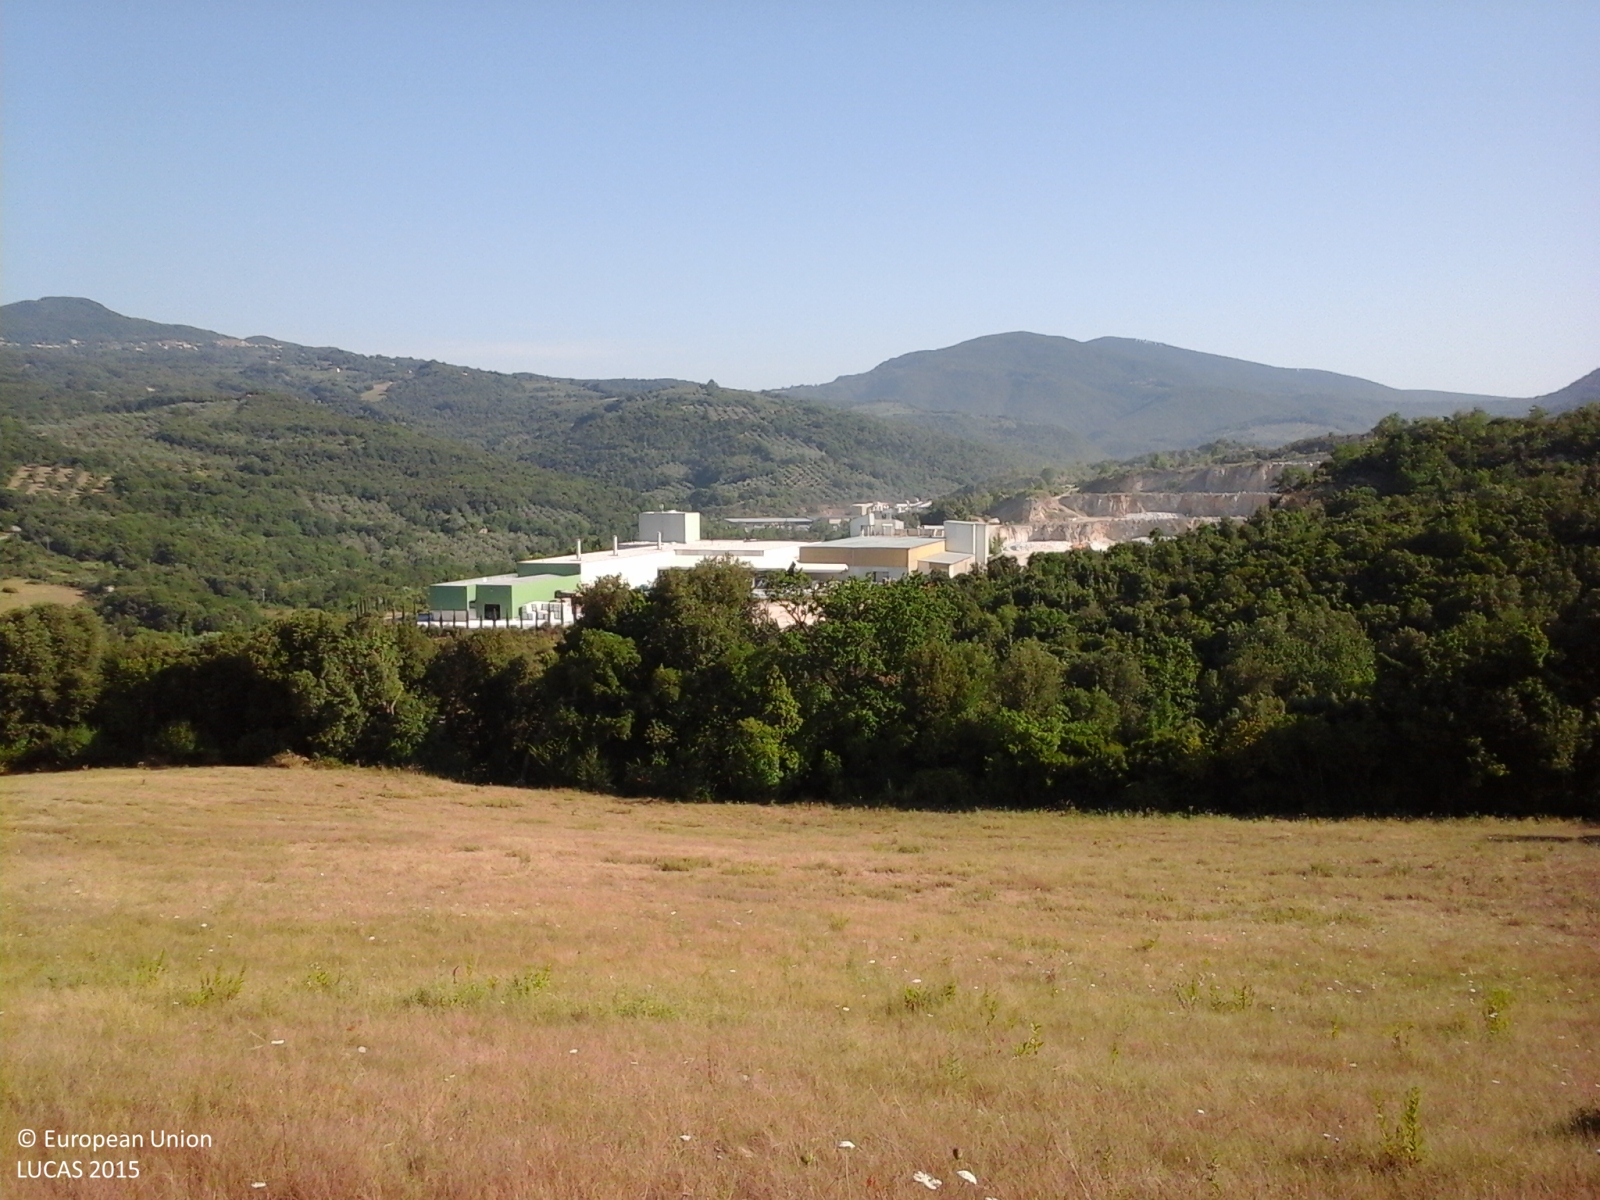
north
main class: Woodland
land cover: Broadleaved woodland
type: thermophilous deciduous forest
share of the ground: > 75 %
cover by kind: broadleaved forest trees 70 %, shrubs 25 %, herbaceous plants 5 %
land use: Forestry
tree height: > 5 m
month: July
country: IT
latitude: 42.9908
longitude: 11.1371
